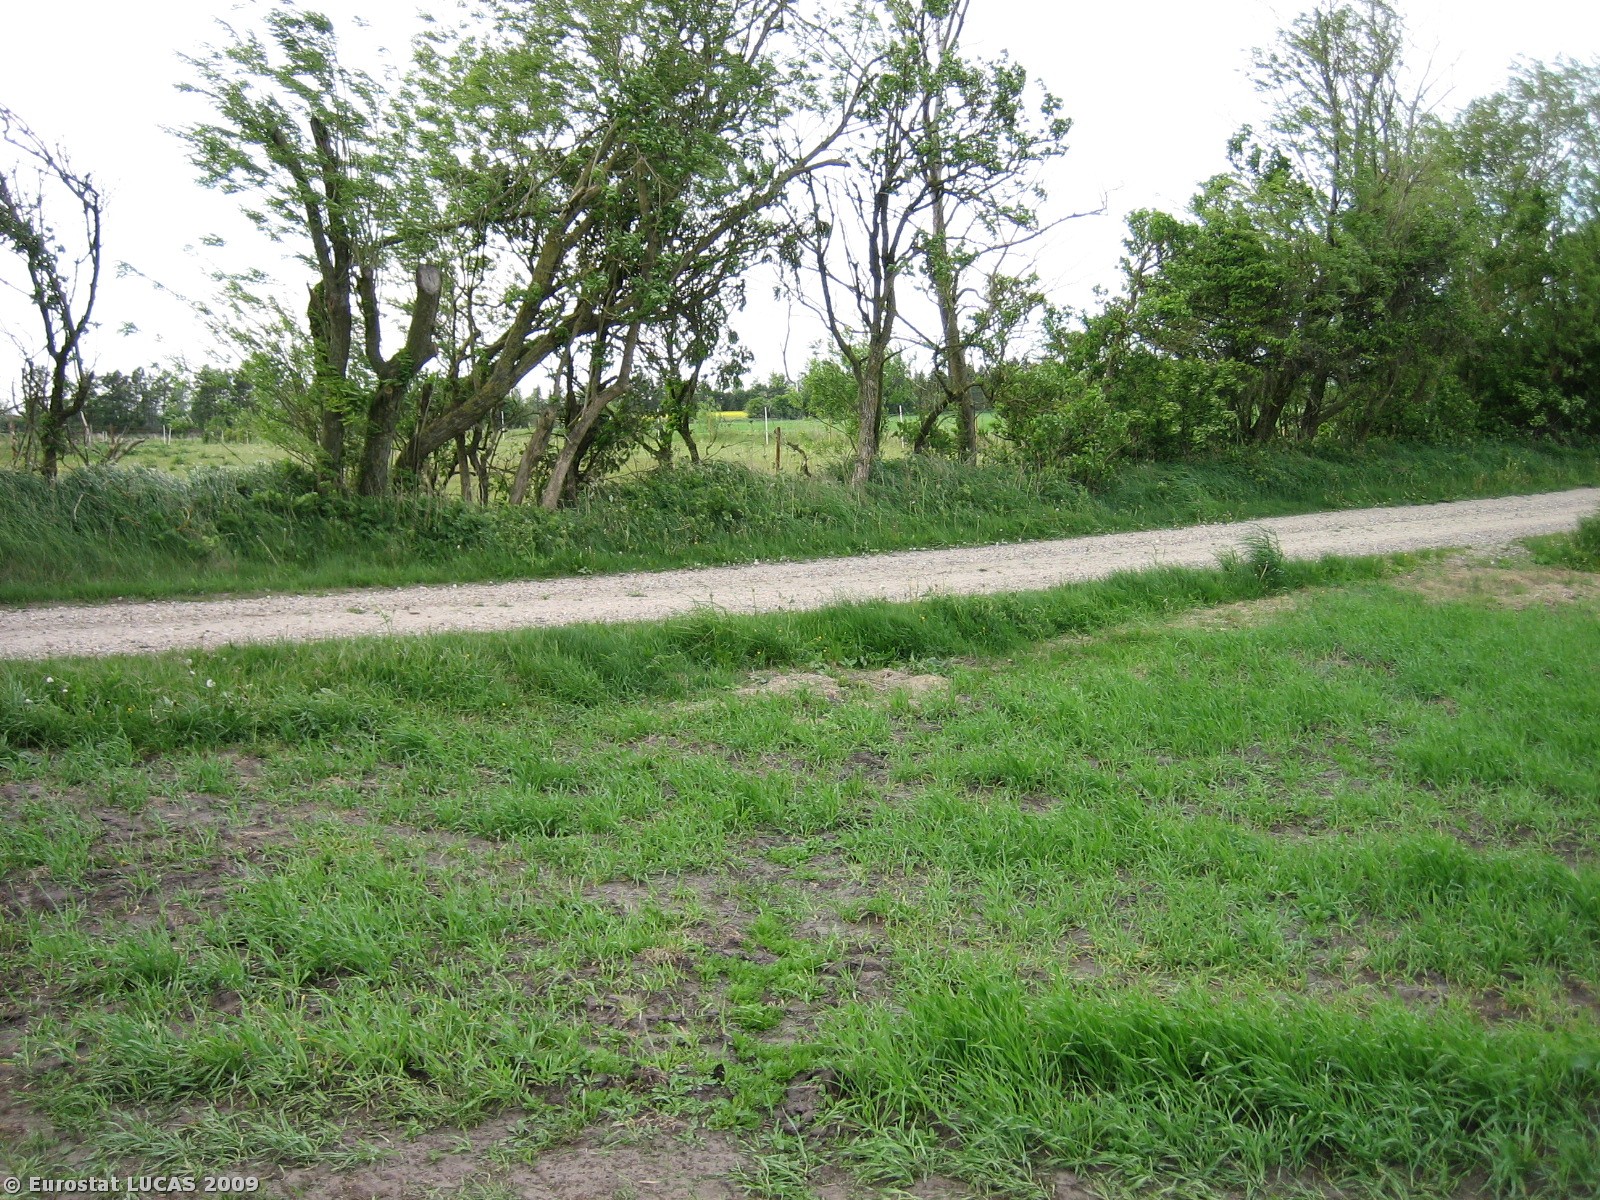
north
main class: Cropland
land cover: Barley
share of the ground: > 75 %
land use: Agriculture (excluding fallow land and kitchen gardens)
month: May
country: DK
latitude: 56.0872
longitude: 8.3465
